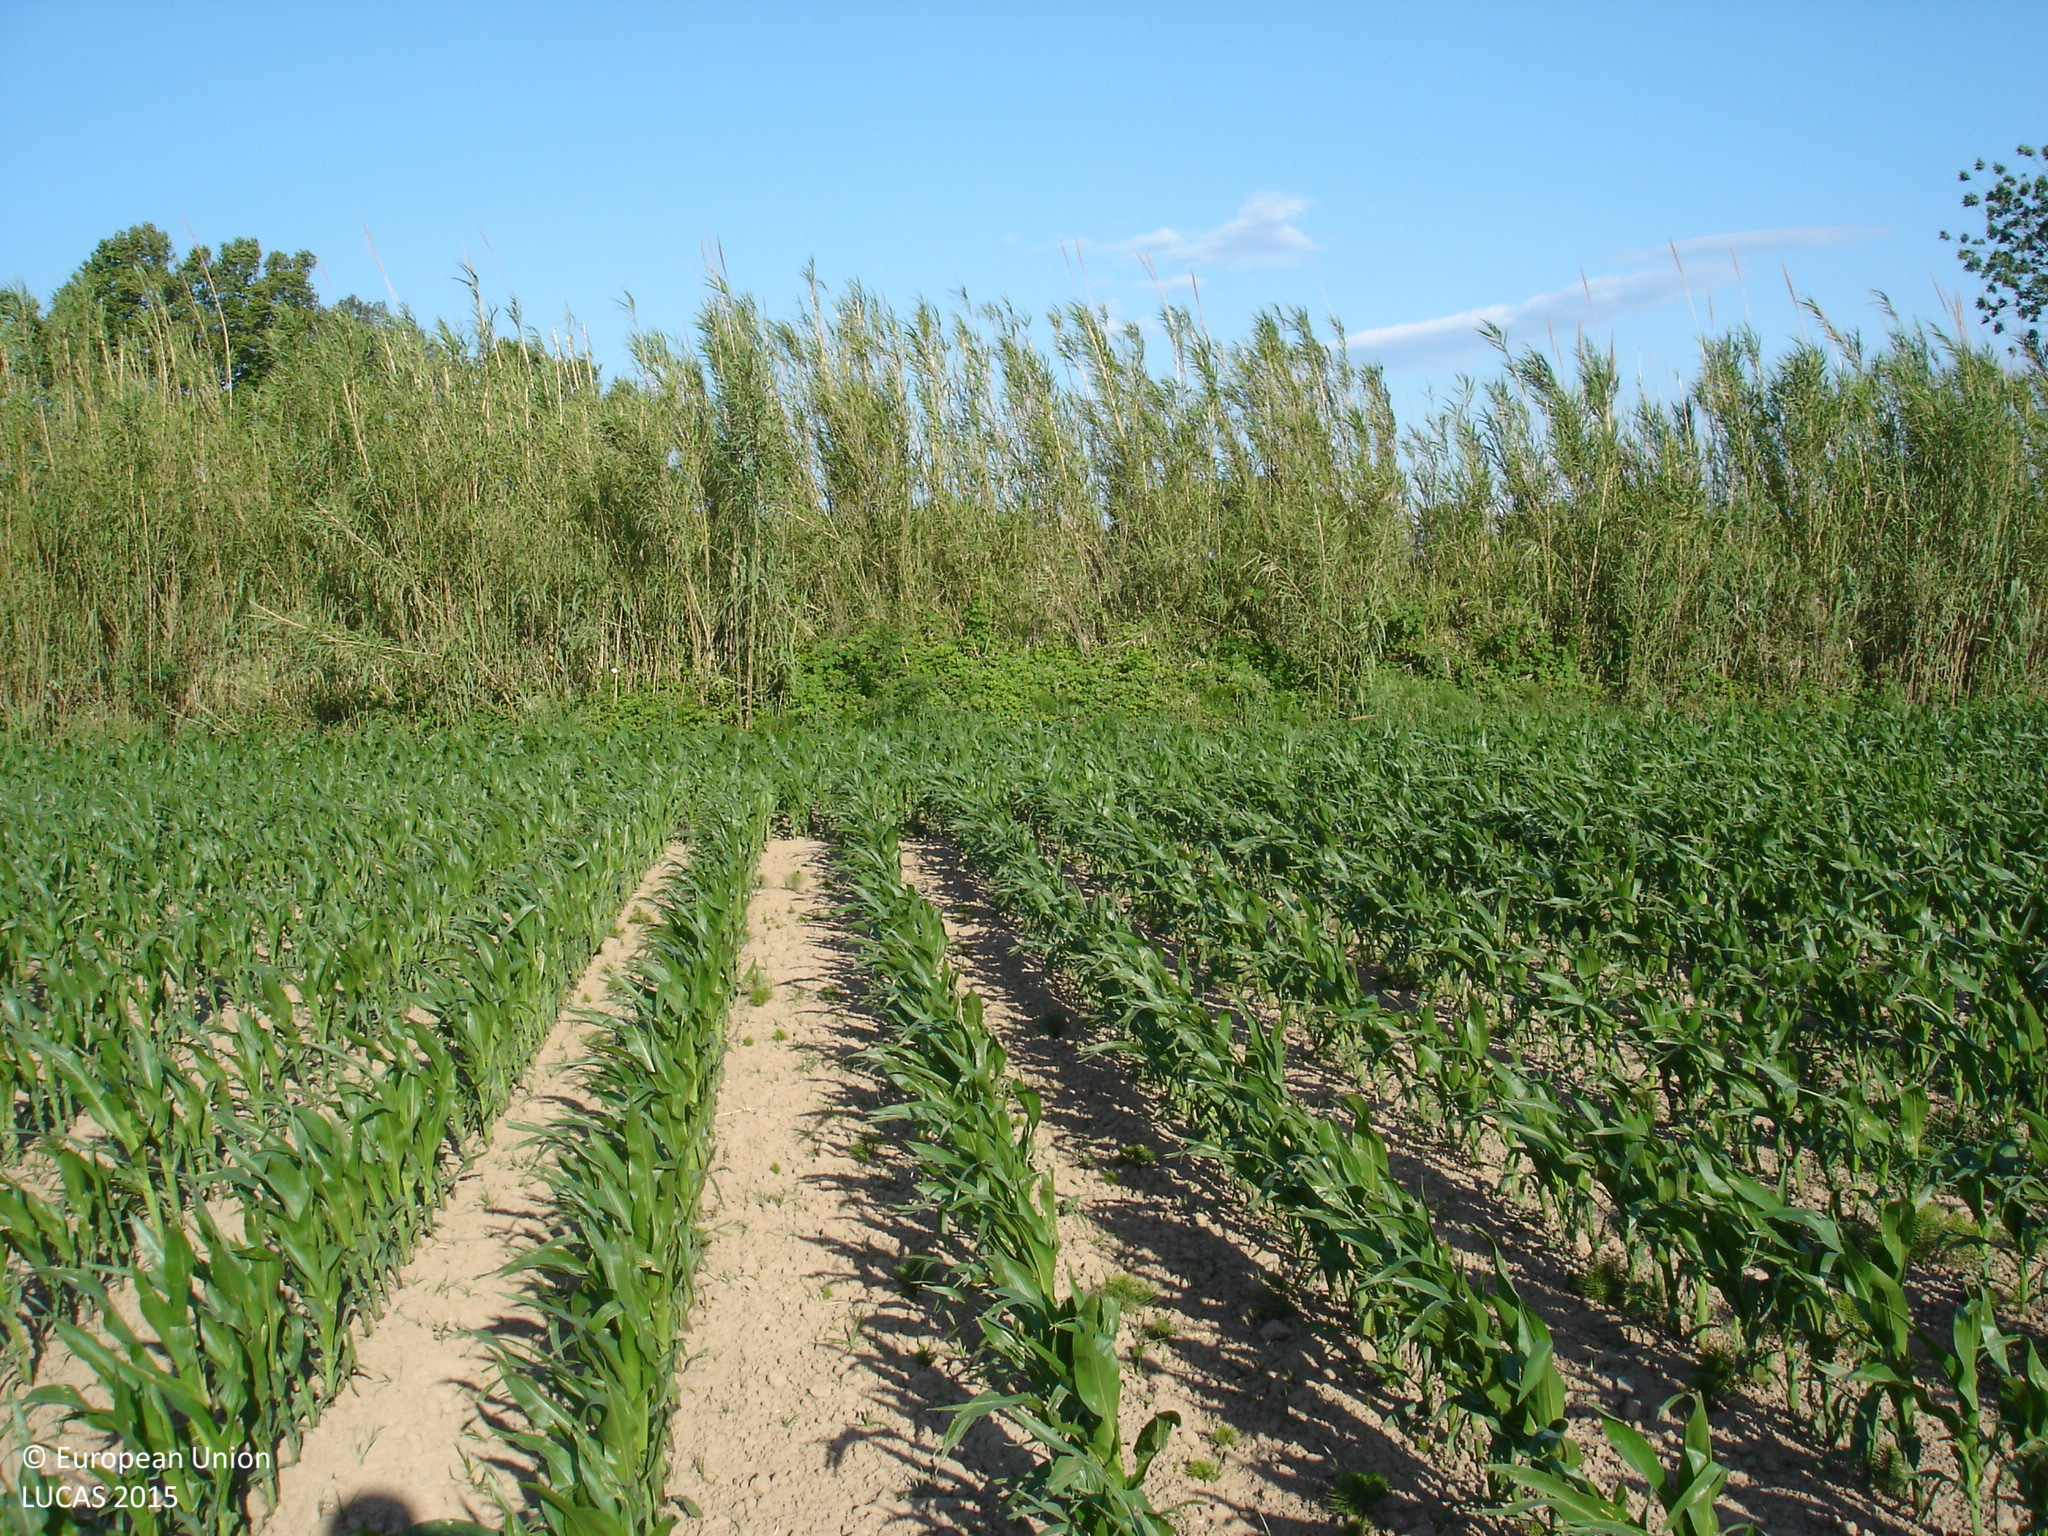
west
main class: Cropland
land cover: Maize
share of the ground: 25 - 50 %
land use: Agriculture (excluding fallow land and kitchen gardens)
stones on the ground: < 10 %
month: May
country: ES
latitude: 42.3023
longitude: 2.9906
